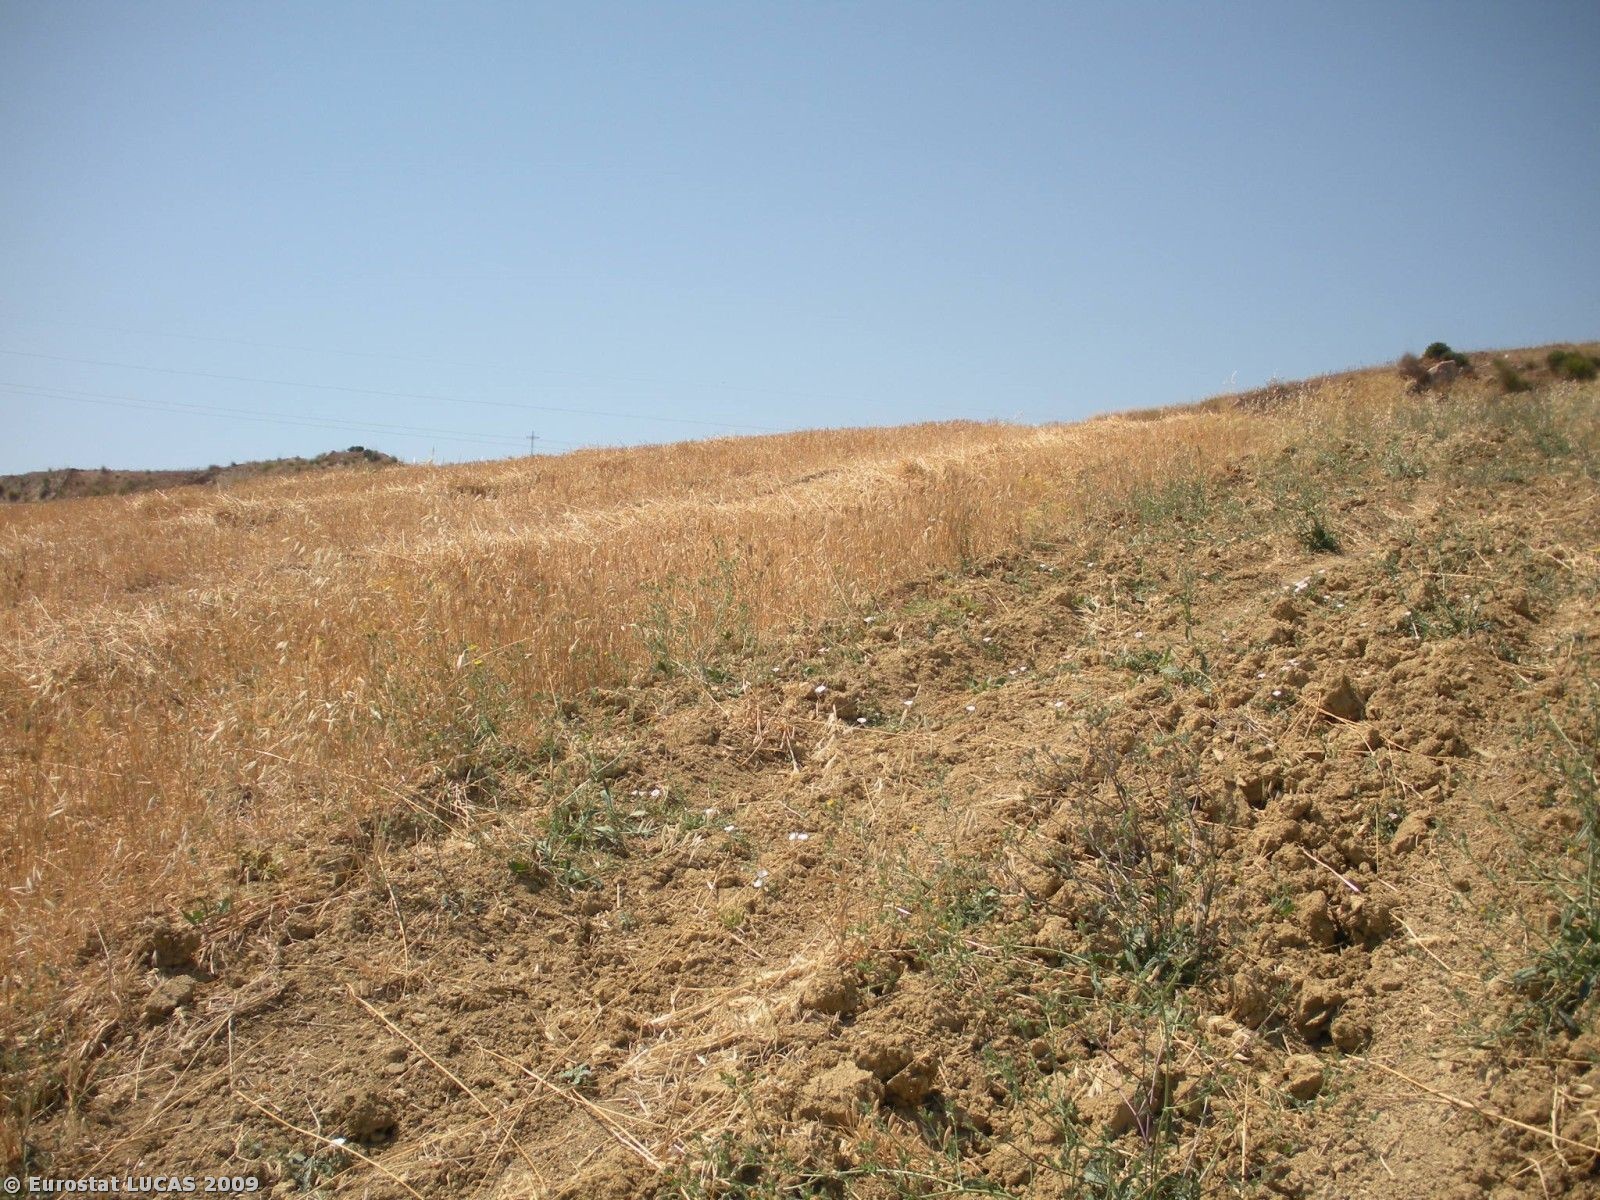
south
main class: Cropland
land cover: Temporary grasslands
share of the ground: > 75 %
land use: Agriculture (excluding fallow land and kitchen gardens)
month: July
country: IT
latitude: 37.9835
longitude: 12.6337
